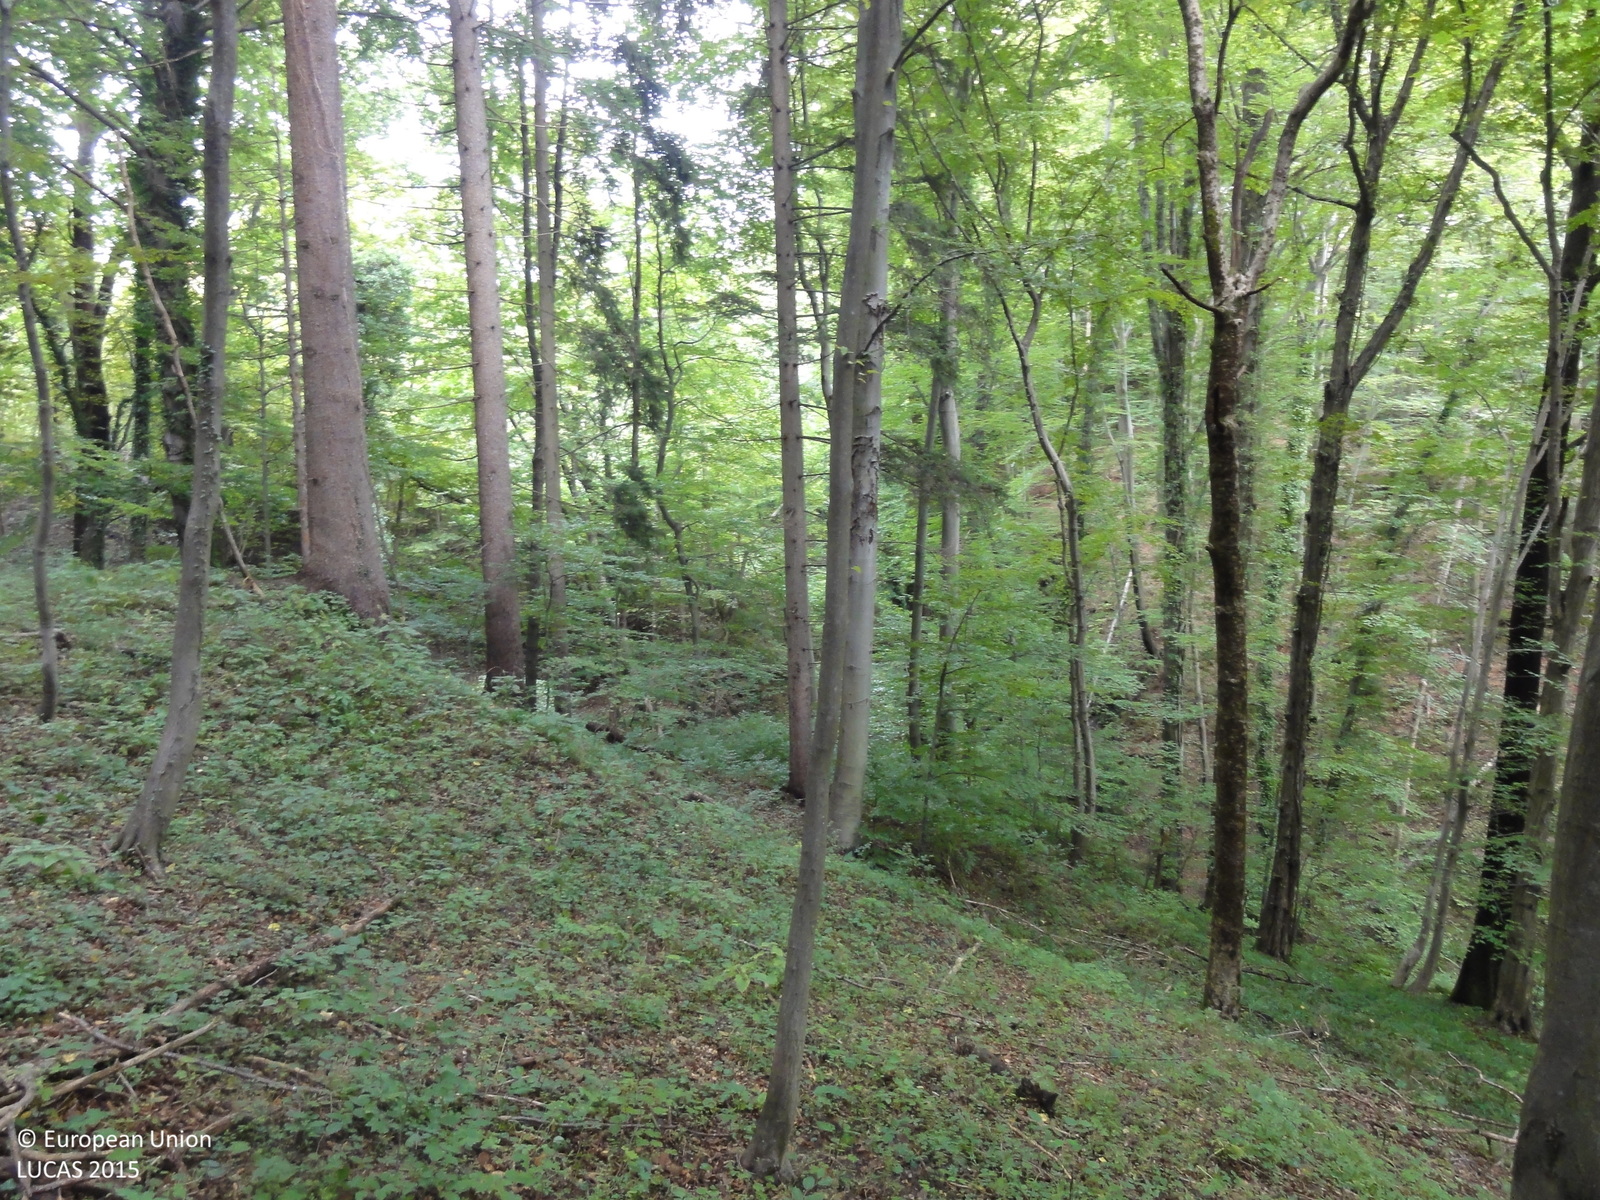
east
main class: Woodland
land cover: Broadleaved woodland
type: mesophytic deciduous forest
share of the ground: > 75 %
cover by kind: broadleaved forest trees 95 %, coniferous forest trees 5 %
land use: Forestry
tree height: > 5 m
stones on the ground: < 10 %
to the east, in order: Broadleaved woodland; Rivers and streams; Broadleaved woodland; Artificial constructions in urban areas
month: August
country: SI
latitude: 46.1605
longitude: 15.0347
